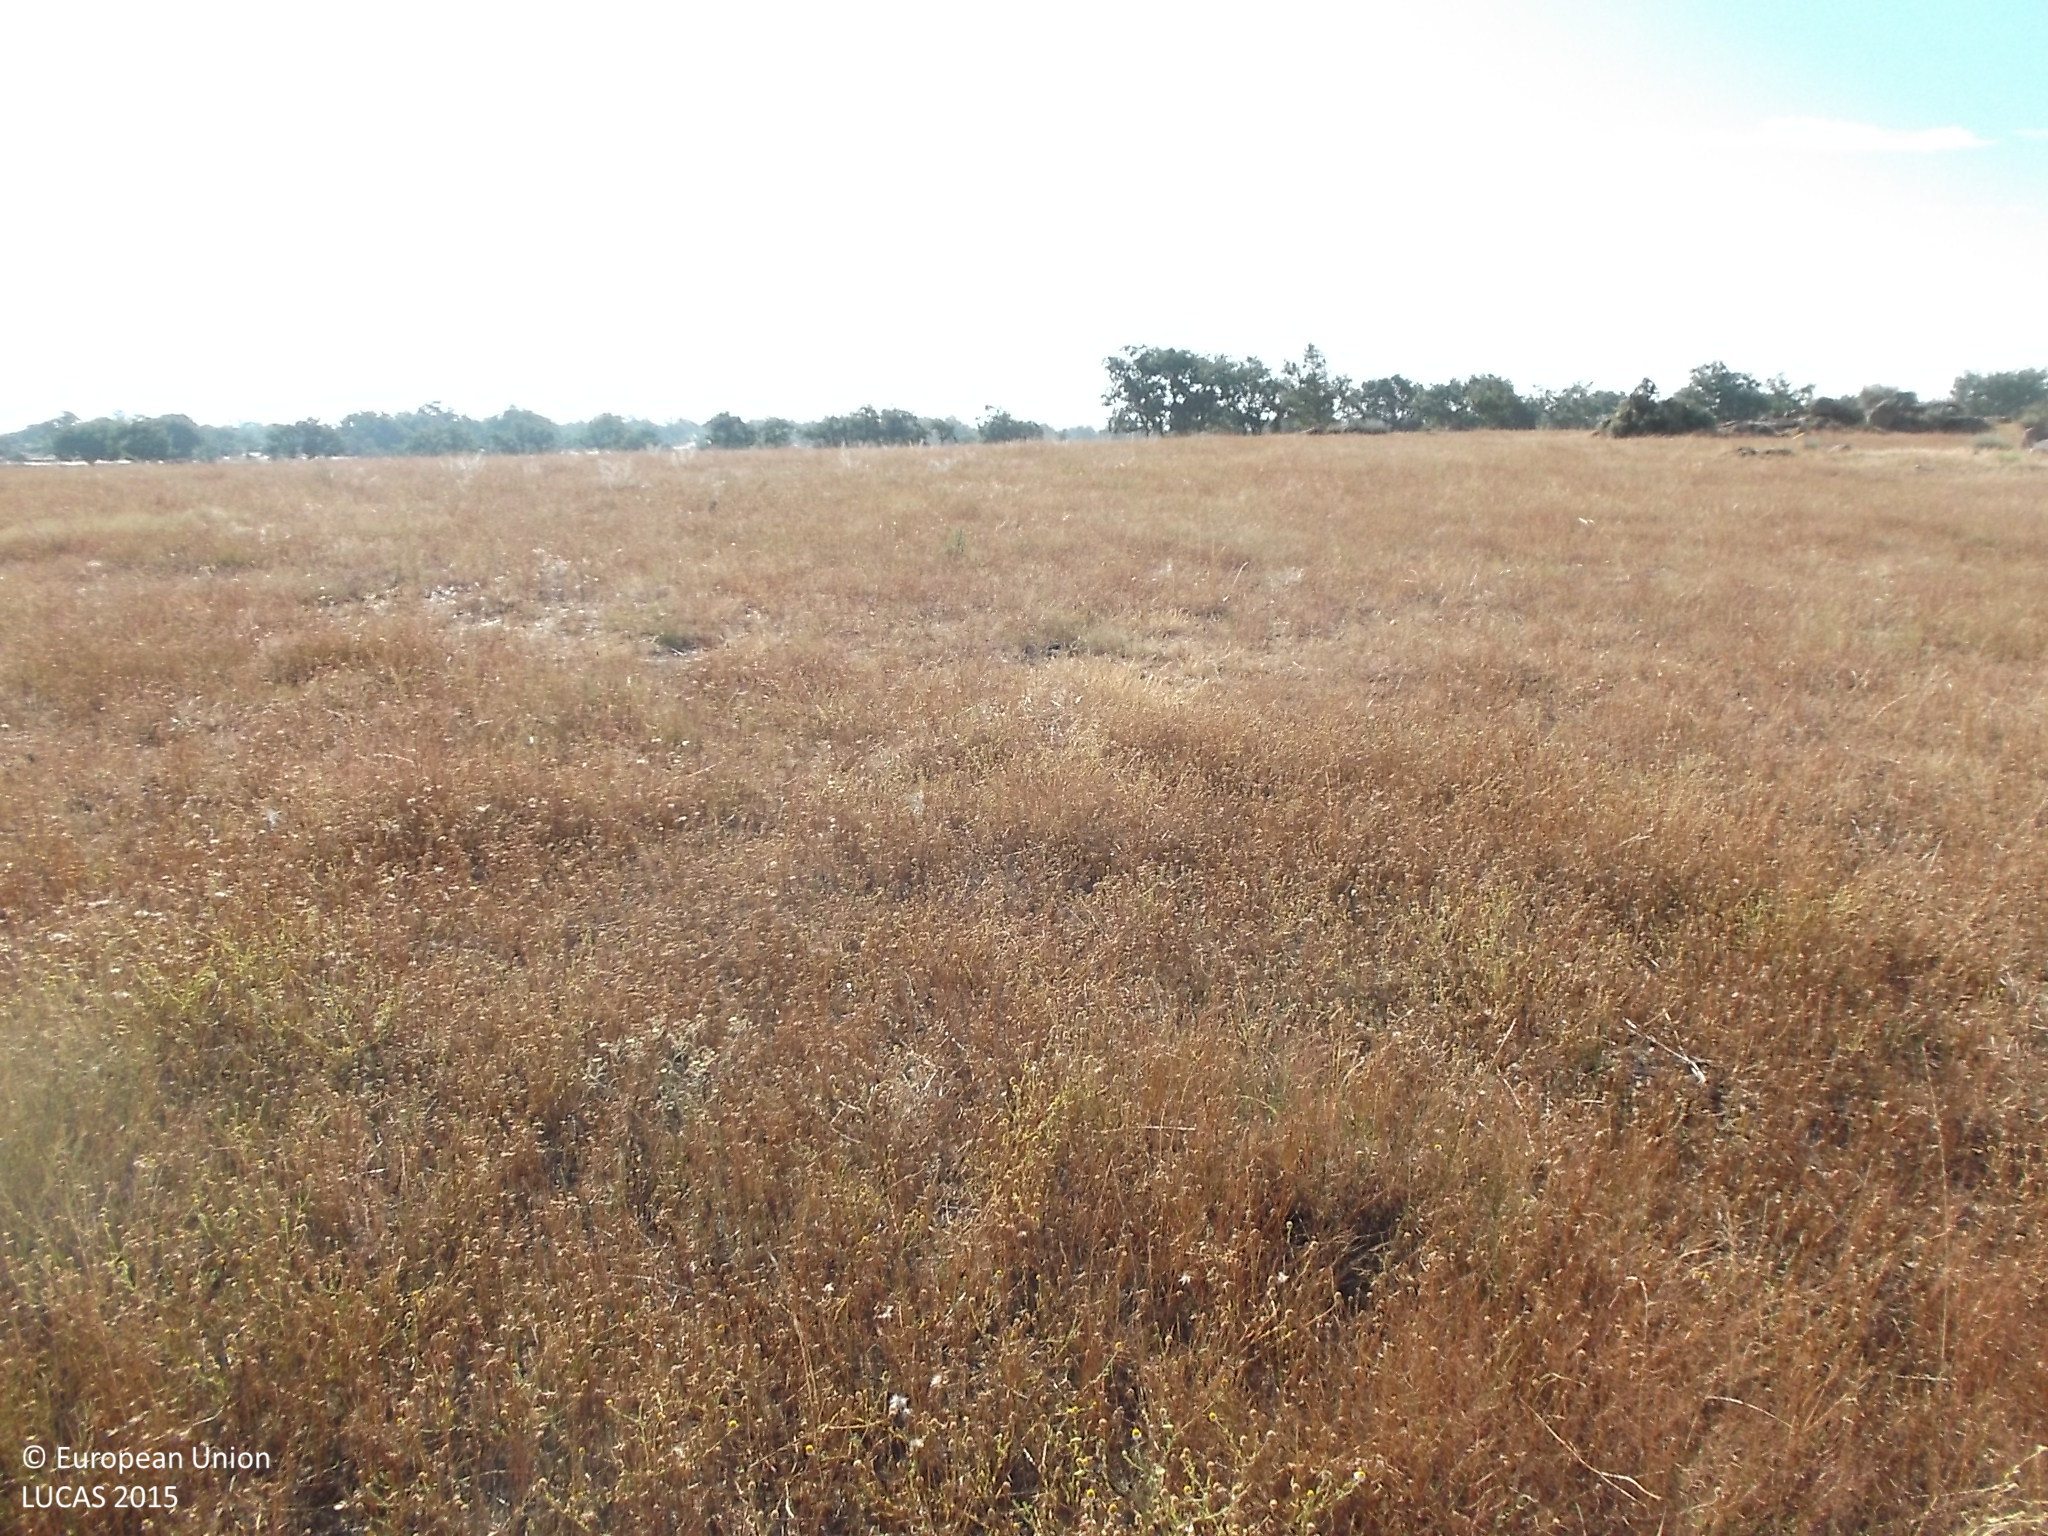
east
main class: Grassland
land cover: Grassland without tree/shrub cover
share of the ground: > 75 %
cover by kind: herbaceous plants 100 %
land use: Agriculture (excluding fallow land and kitchen gardens)
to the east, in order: Grassland without tree/shrub cover; Single bushes/trees; Grassland without tree/shrub cover; Fences; Grassland without tree/shrub cover
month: July
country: ES
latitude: 41.2261
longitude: -6.3308
